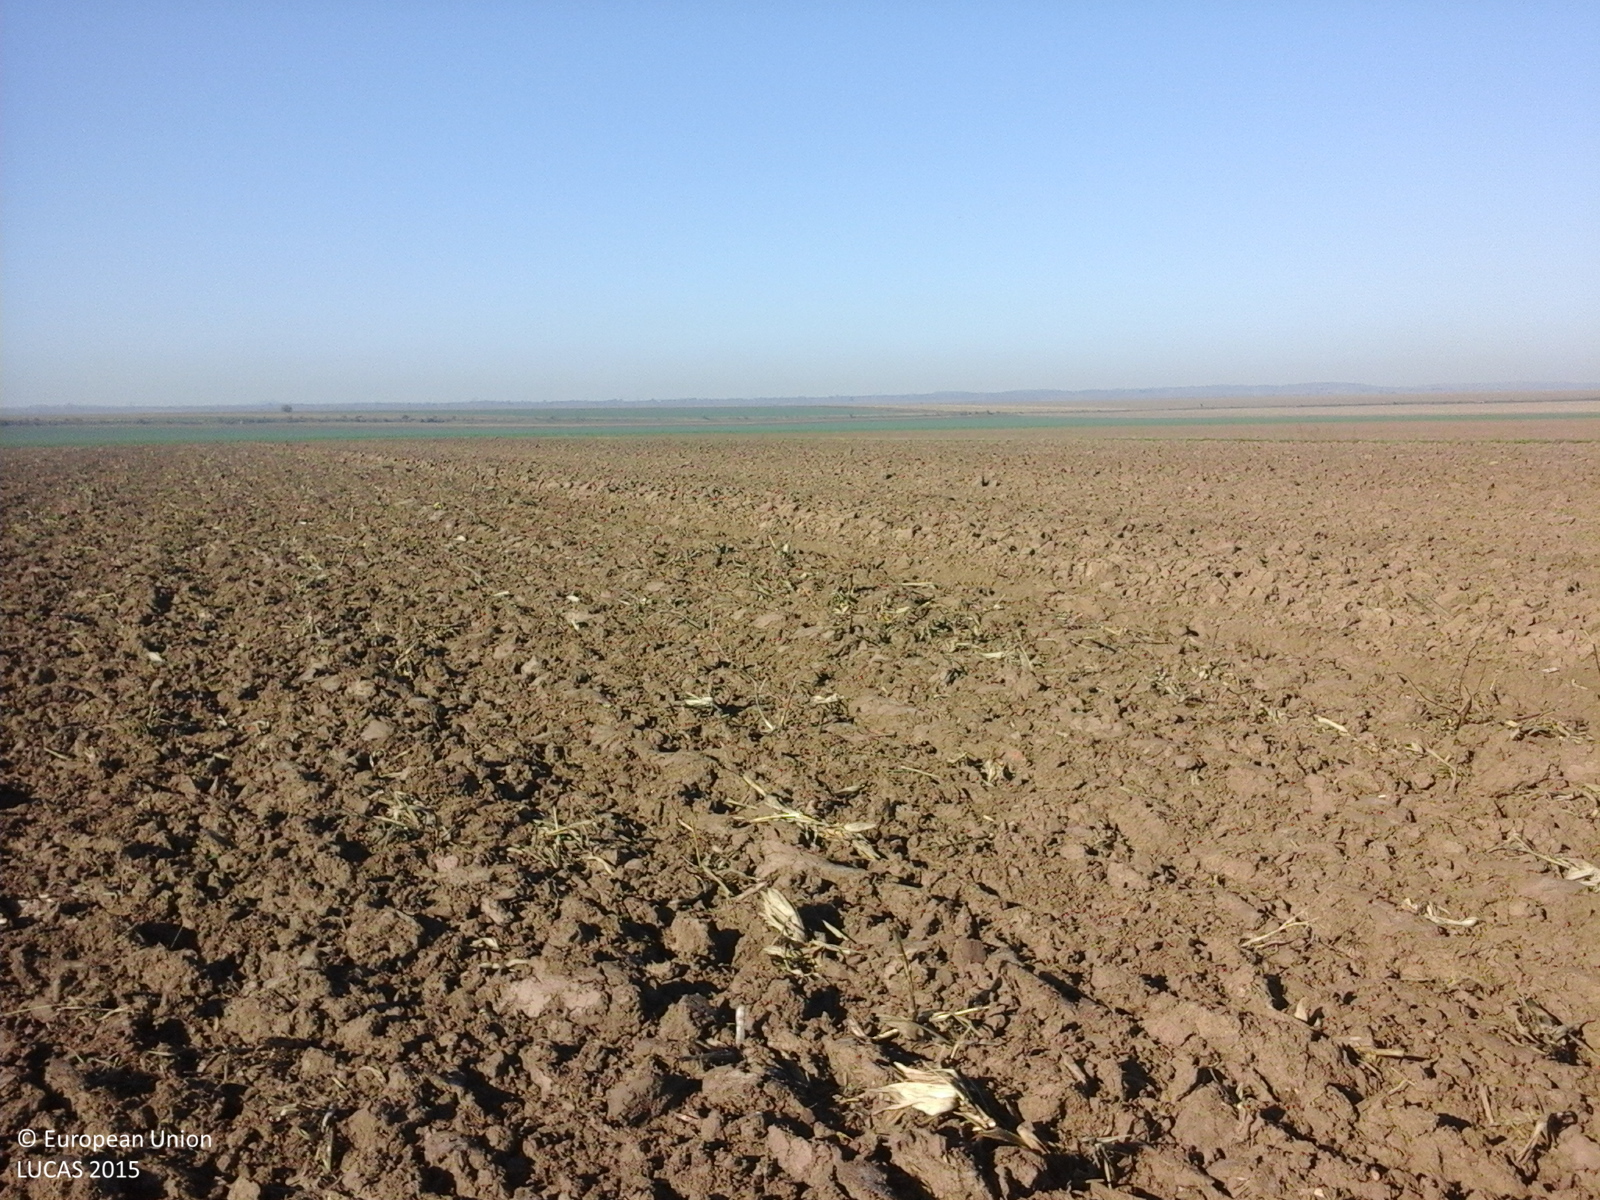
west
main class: Cropland
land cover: Maize
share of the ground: < 10 %
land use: Agriculture (excluding fallow land and kitchen gardens)
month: October
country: RO
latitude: 45.9575
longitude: 27.1931
